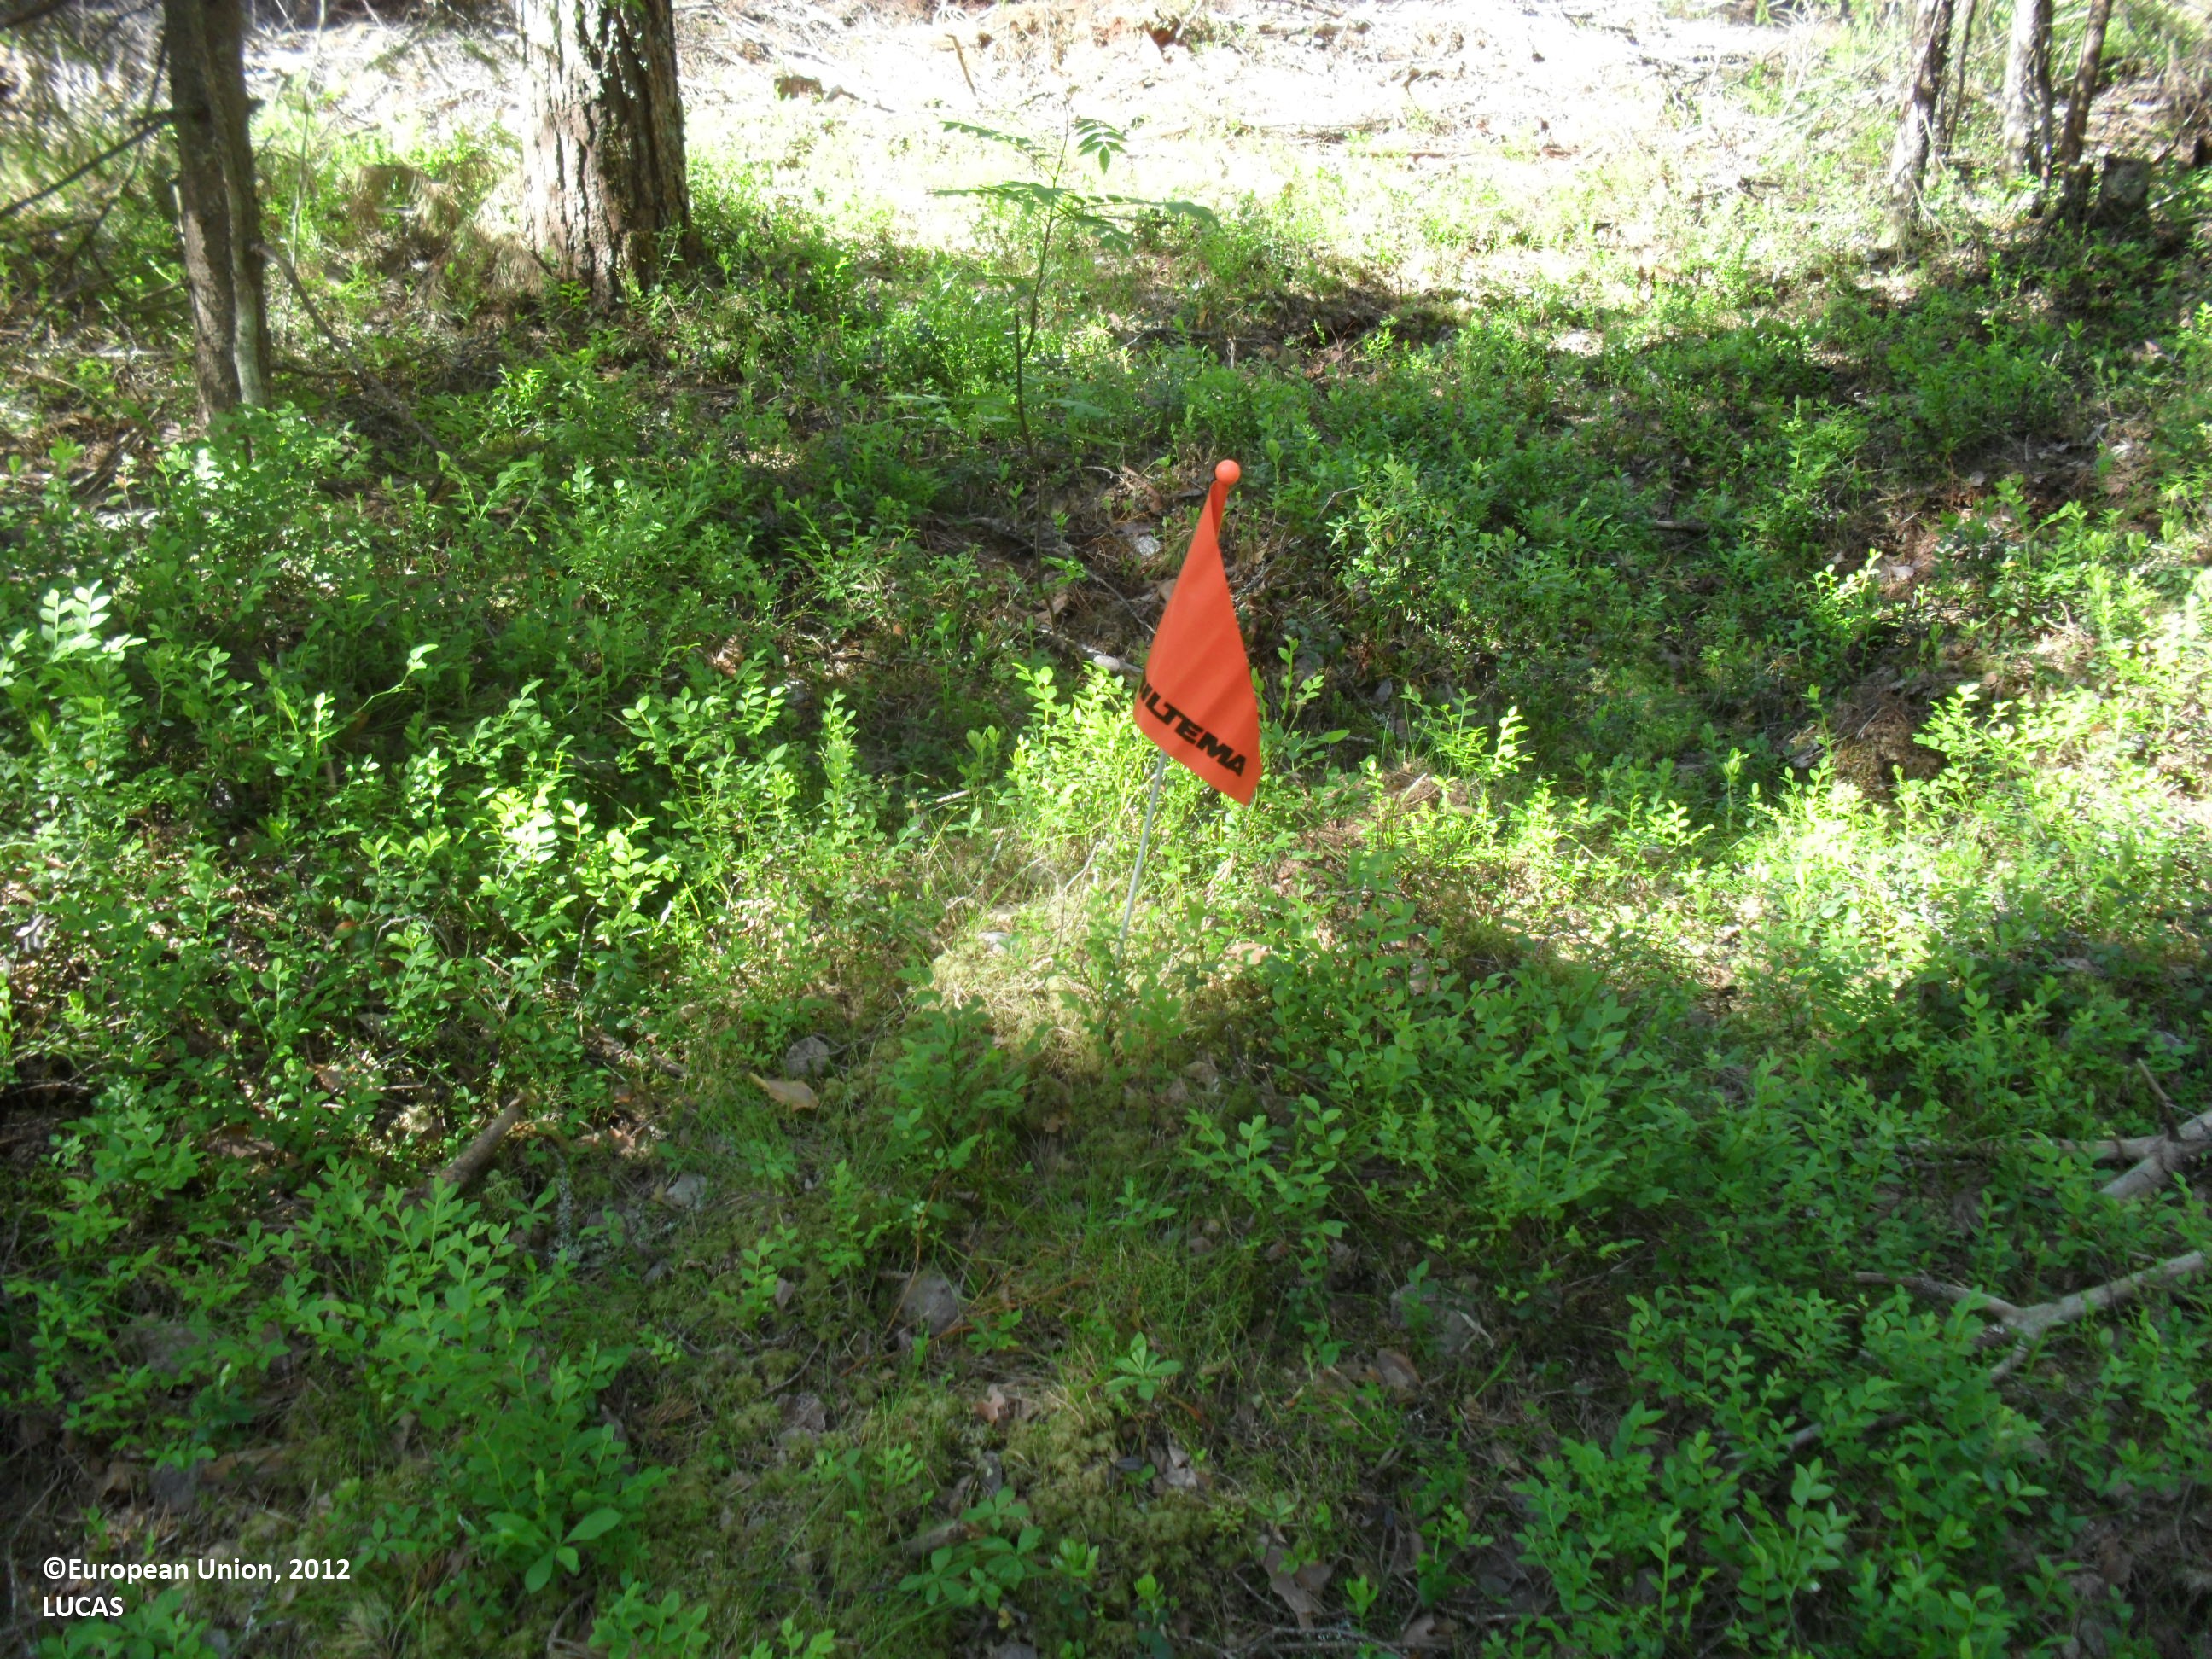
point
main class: Woodland
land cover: Other mixed woodland
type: boreal forest
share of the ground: 25 - 50 %
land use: Forestry
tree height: > 5 m
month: June
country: FI
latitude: 63.2248
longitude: 22.9289
